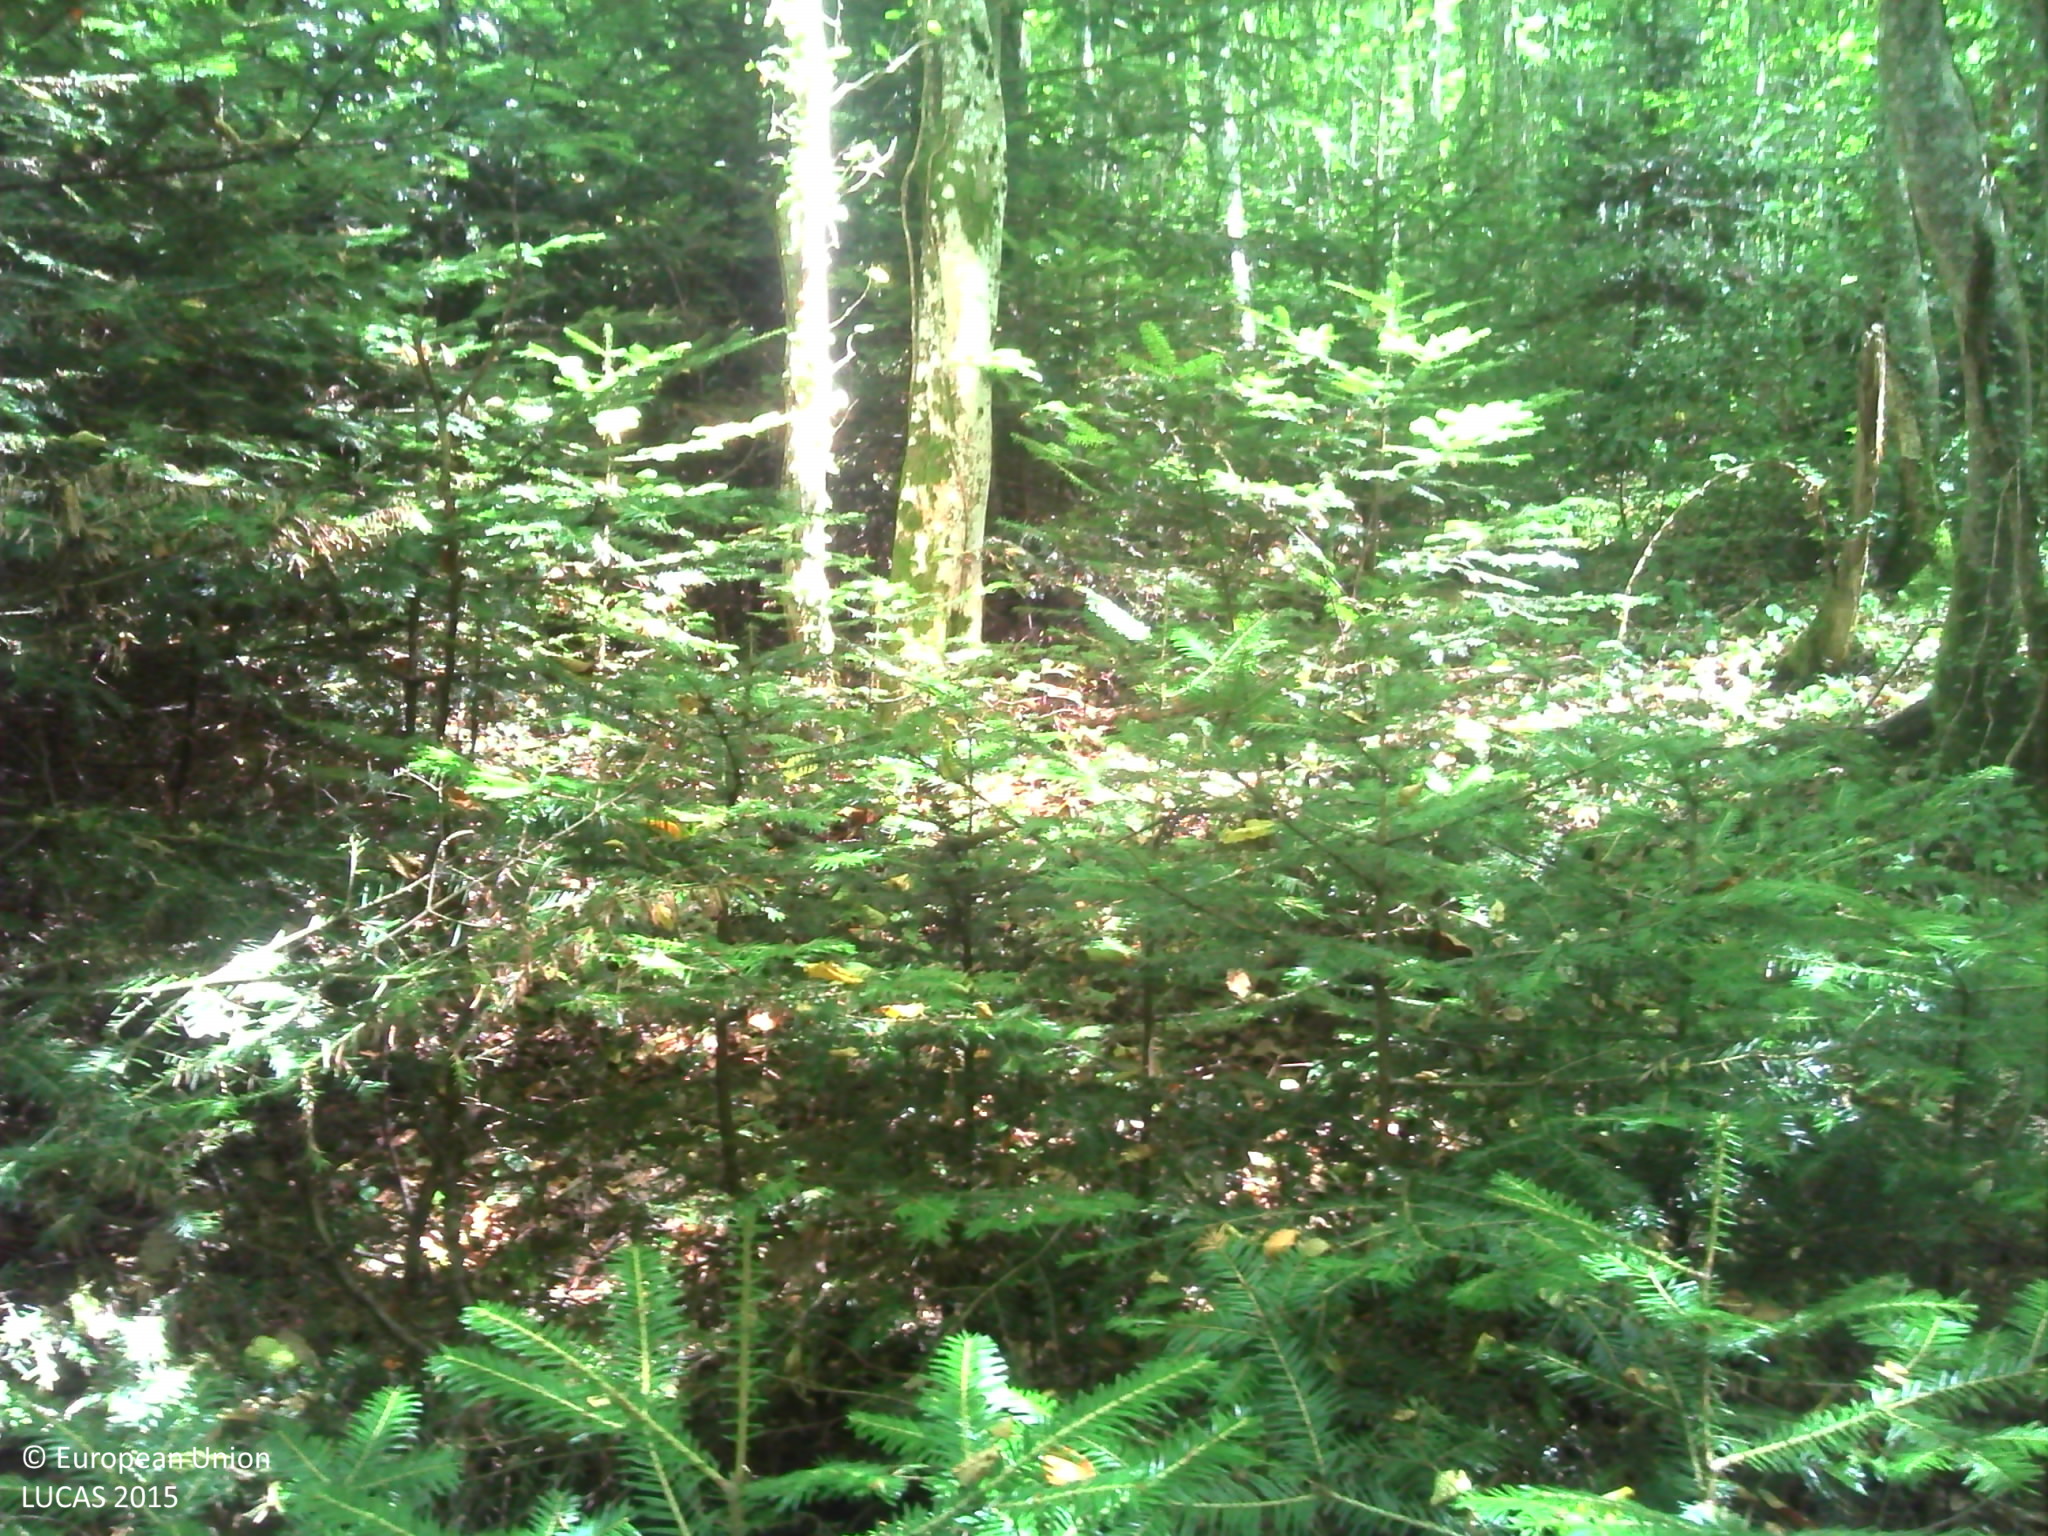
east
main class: Woodland
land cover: Other mixed woodland
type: mountainous beech forest
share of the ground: > 75 %
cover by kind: coniferous forest trees 40 %, broadleaved forest trees 40 %, herbaceous plants 20 %
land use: Forestry
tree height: > 5 m
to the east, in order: Other mixed woodland; Tracks; Other mixed woodland; Tracks; Other mixed woodland; Spontaneously vegetated surfaces; Other mixed woodland; Tracks; Broadleaved woodland
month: July
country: FR
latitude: 45.7757
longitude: 4.4859
